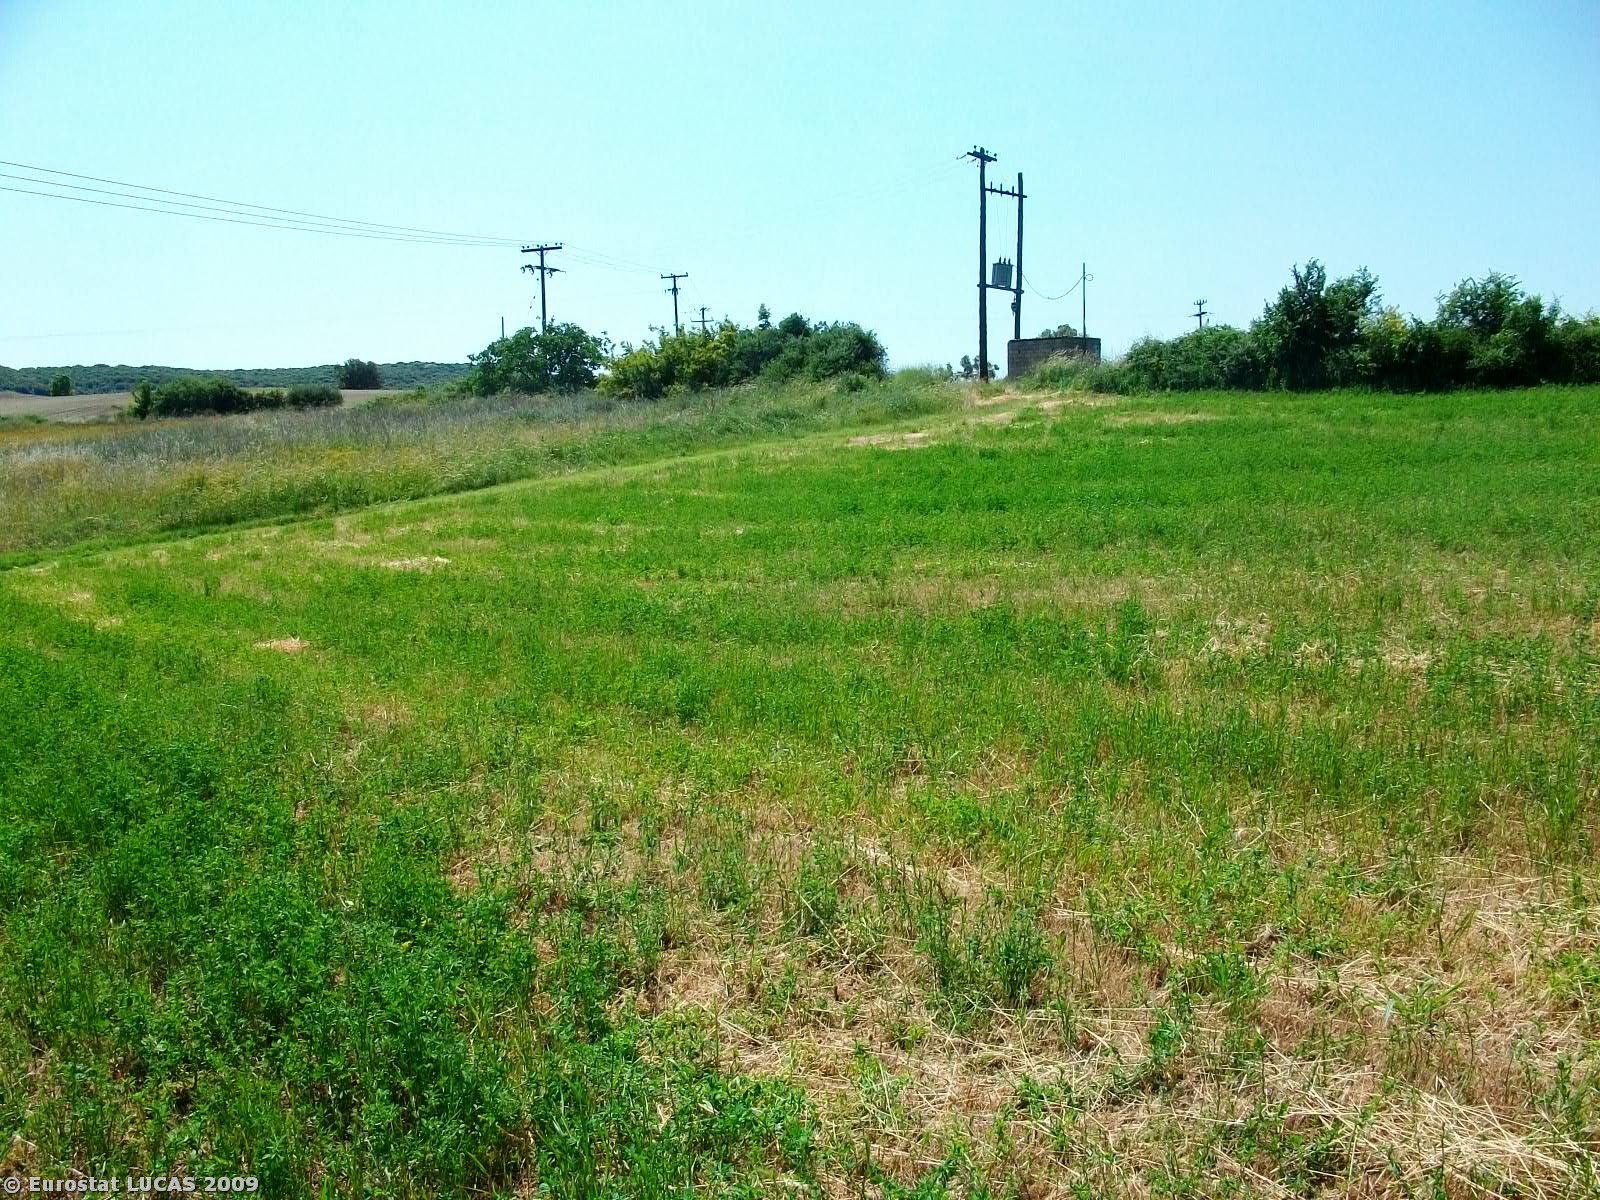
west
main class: Cropland
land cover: Clovers
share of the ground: > 75 %
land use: Agriculture (excluding fallow land and kitchen gardens)
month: May
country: GR
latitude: 40.9202
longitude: 25.4979
